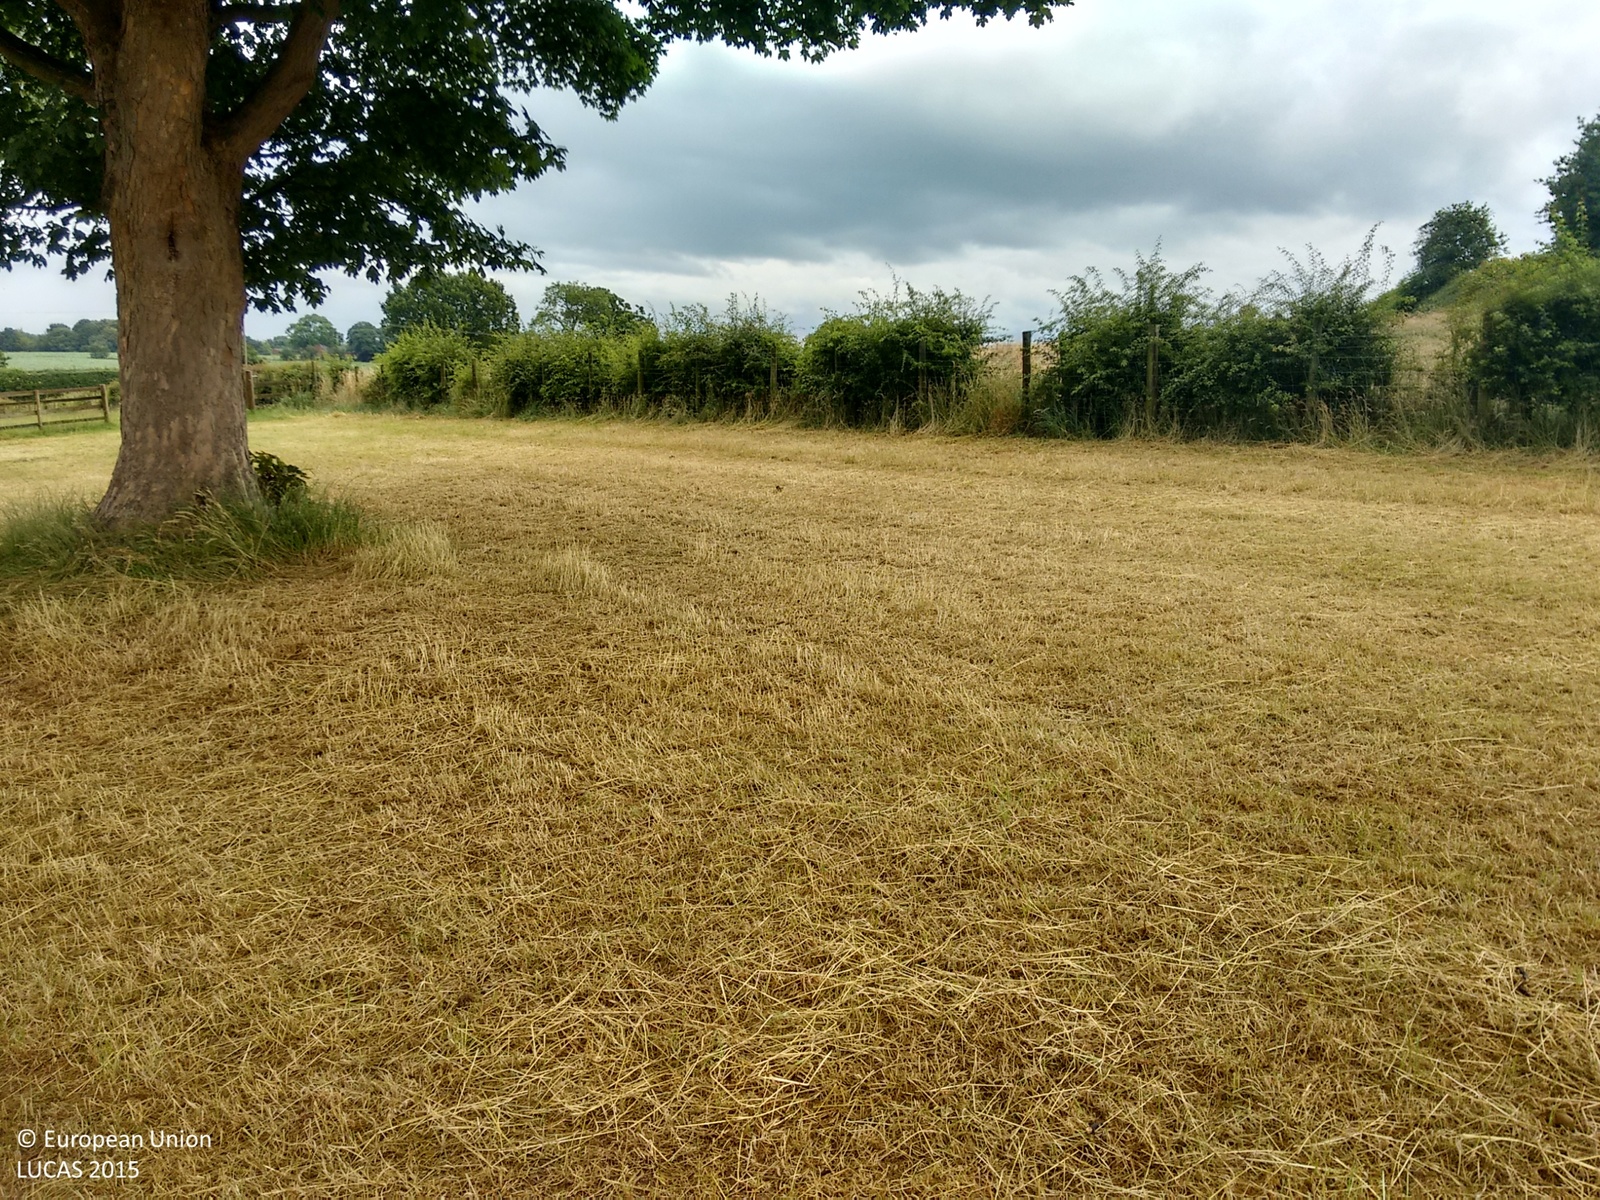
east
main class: Grassland
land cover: Grassland without tree/shrub cover
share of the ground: > 75 %
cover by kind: herbaceous plants 100 %
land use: Agriculture (excluding fallow land and kitchen gardens)
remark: Harvested field
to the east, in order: Grassland without tree/shrub cover; Single bushes/trees; Grassland without tree/shrub cover; Fences; Grass margins; Fences; Grassland without tree/shrub cover; Fences; Grassland without tree/shrub cover; Abandoned hedges; Grassland without tree/shrub cover
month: July
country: GB
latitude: 52.9288
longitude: -2.3664
